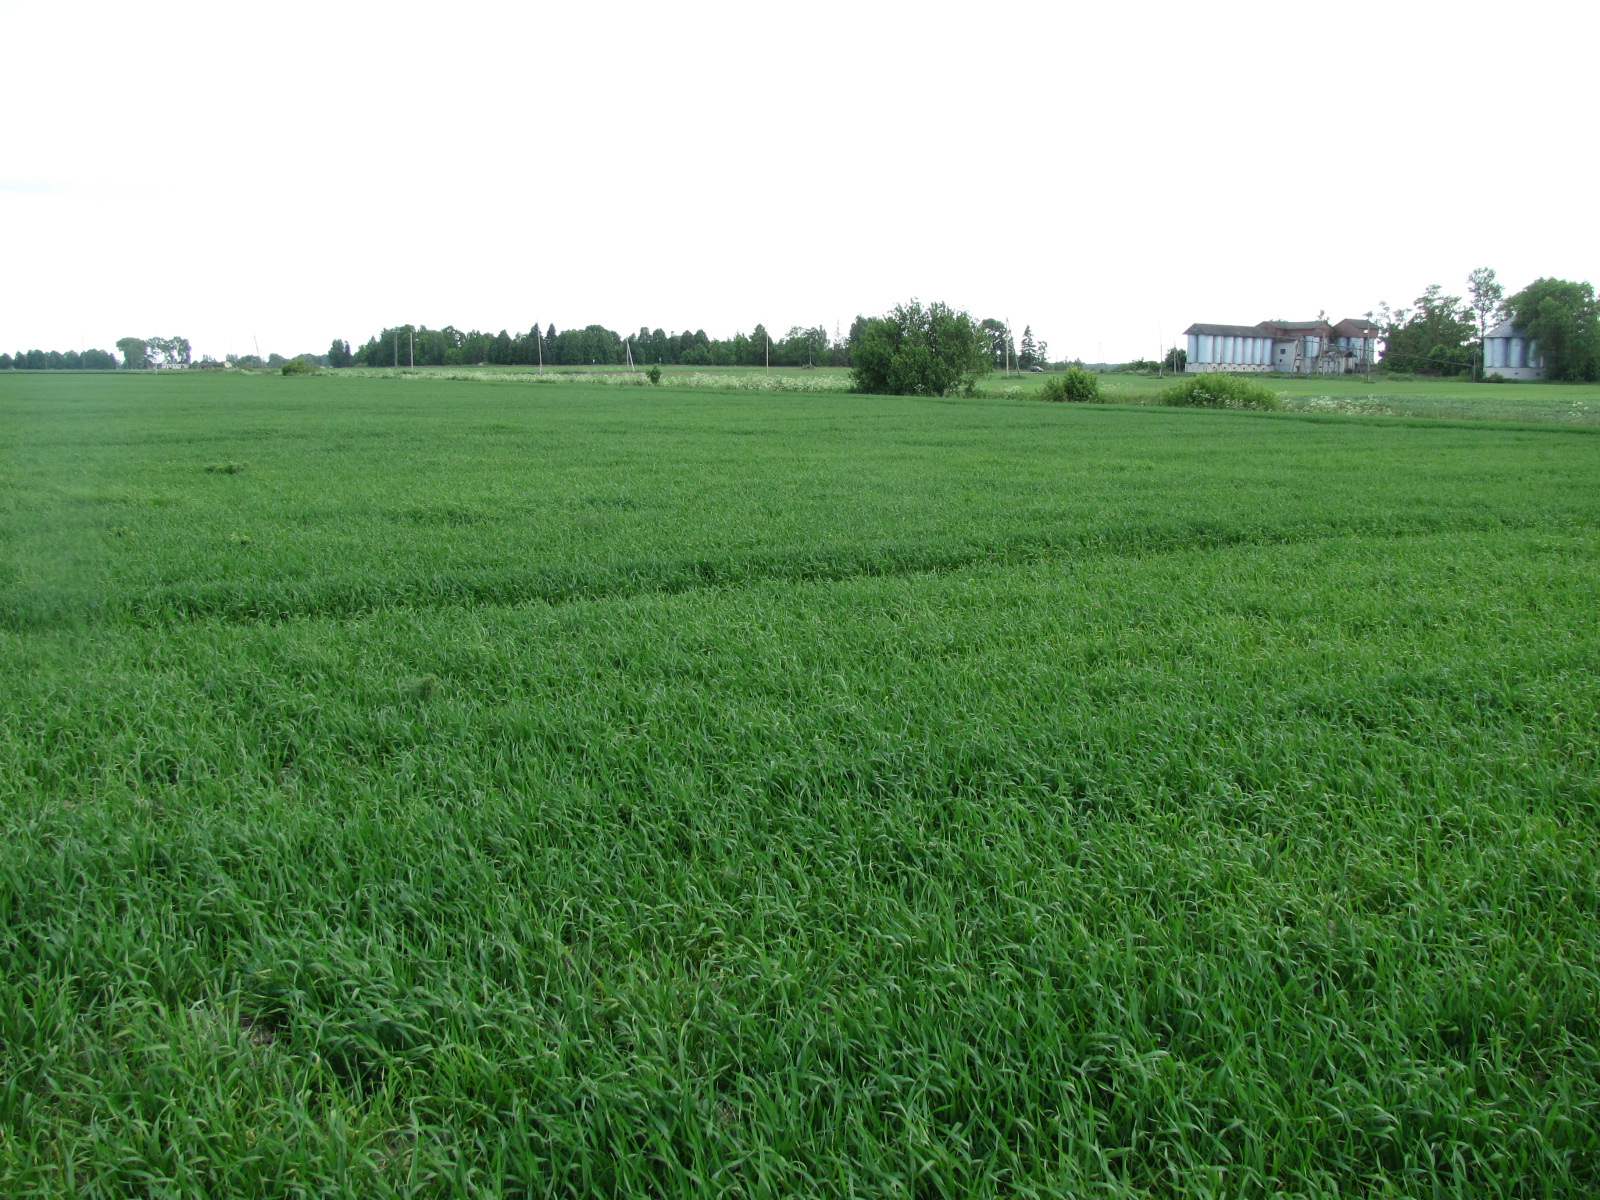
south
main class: Cropland
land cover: Common wheat
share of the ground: > 75 %
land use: Agriculture (excluding fallow land and kitchen gardens)
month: June
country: LV
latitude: 56.3772
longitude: 24.2270
